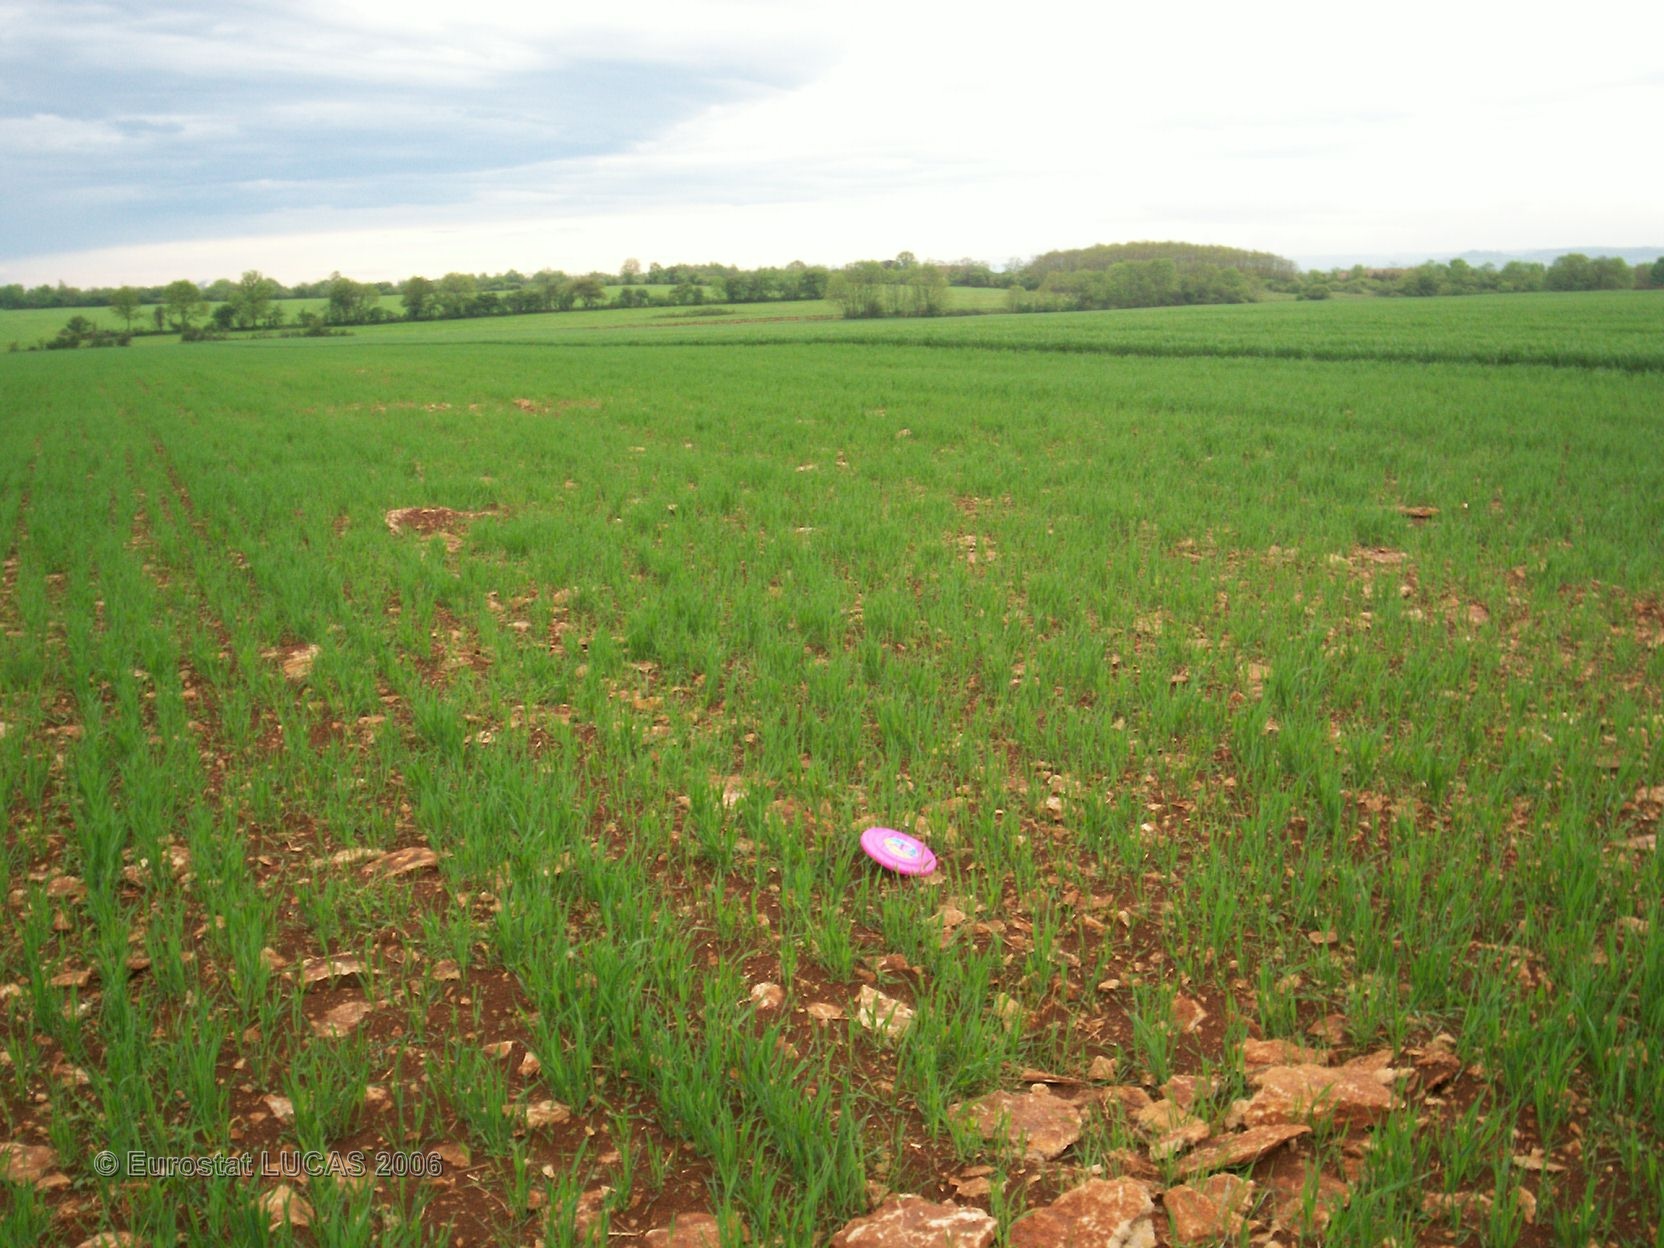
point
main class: Cropland
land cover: Oats
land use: Agriculture (excluding fallow land and kitchen gardens)
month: May
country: FR
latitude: 47.2612
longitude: 4.5946
